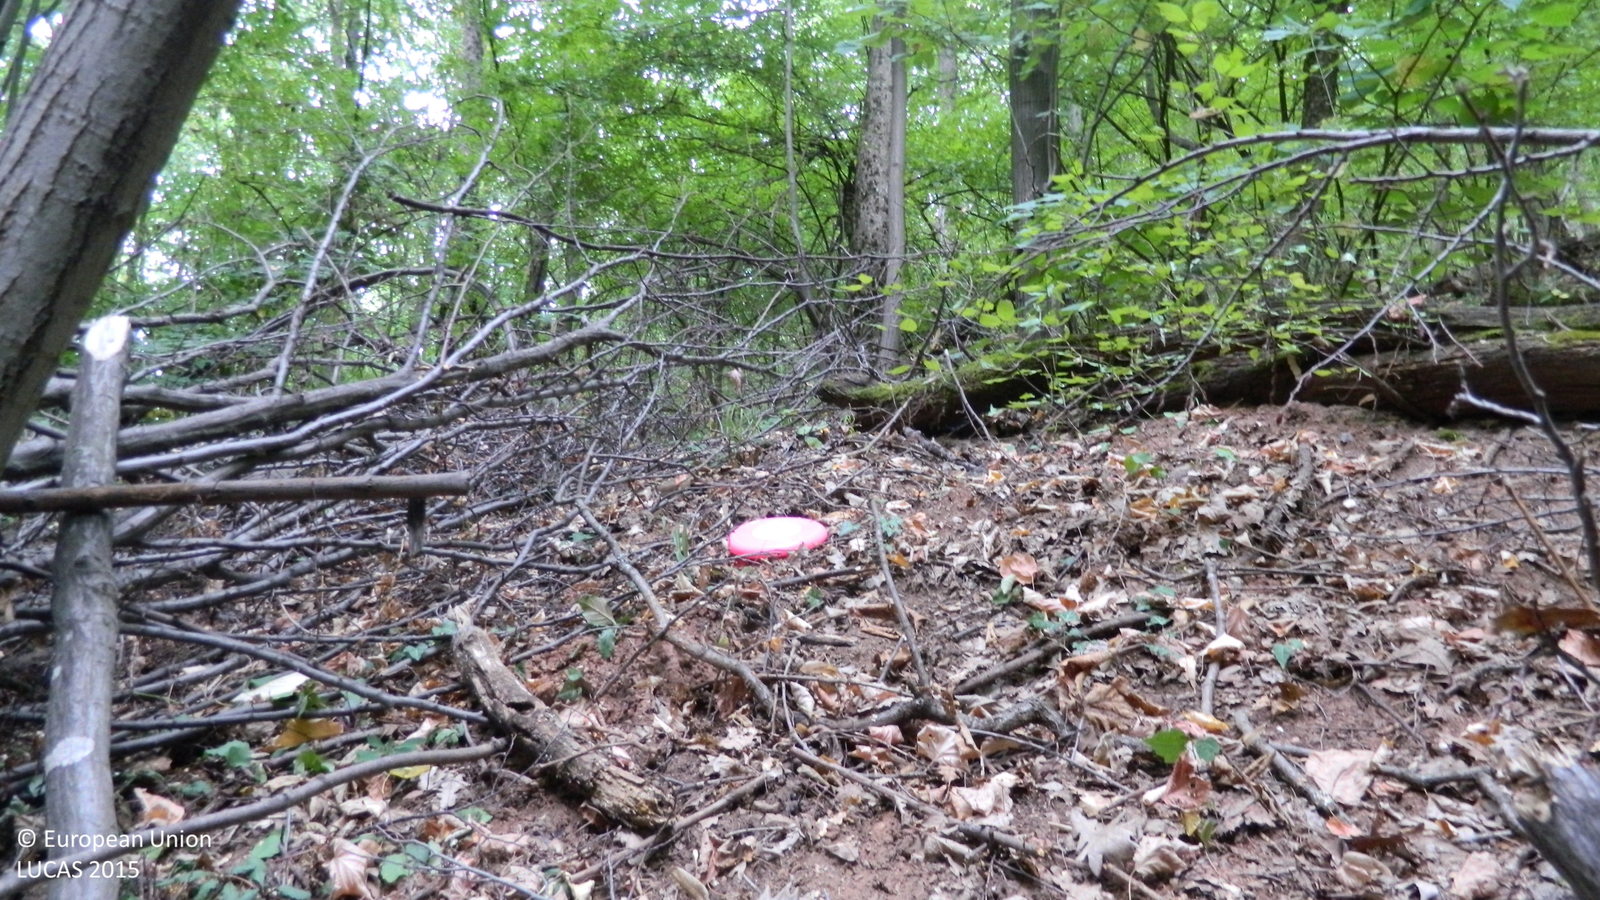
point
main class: Woodland
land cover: Broadleaved woodland
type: mesophytic deciduous forest
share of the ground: > 75 %
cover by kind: broadleaved forest trees 100 %
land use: Forestry
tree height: > 5 m
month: August
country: BG
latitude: 41.7309
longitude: 25.8284
